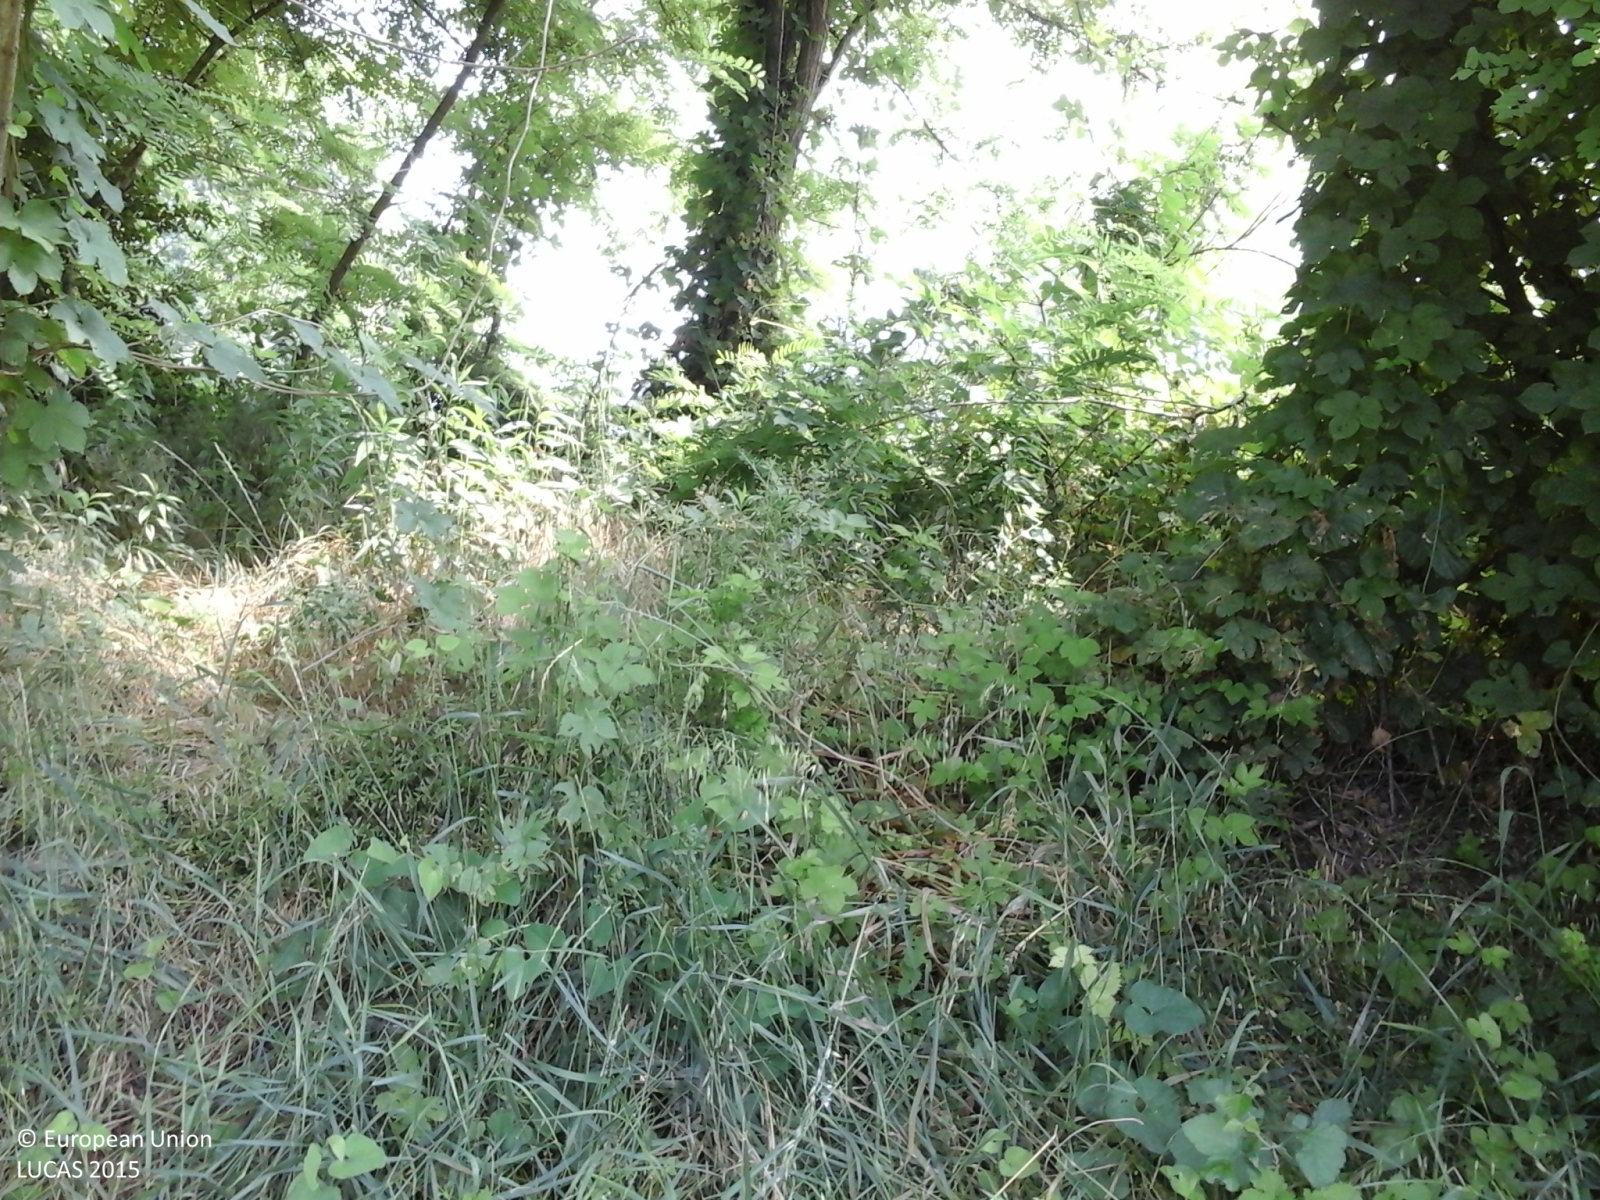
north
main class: Cropland
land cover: Lucerne
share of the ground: > 75 %
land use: Agriculture (excluding fallow land and kitchen gardens)
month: June
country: IT
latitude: 45.0898
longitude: 10.0127
